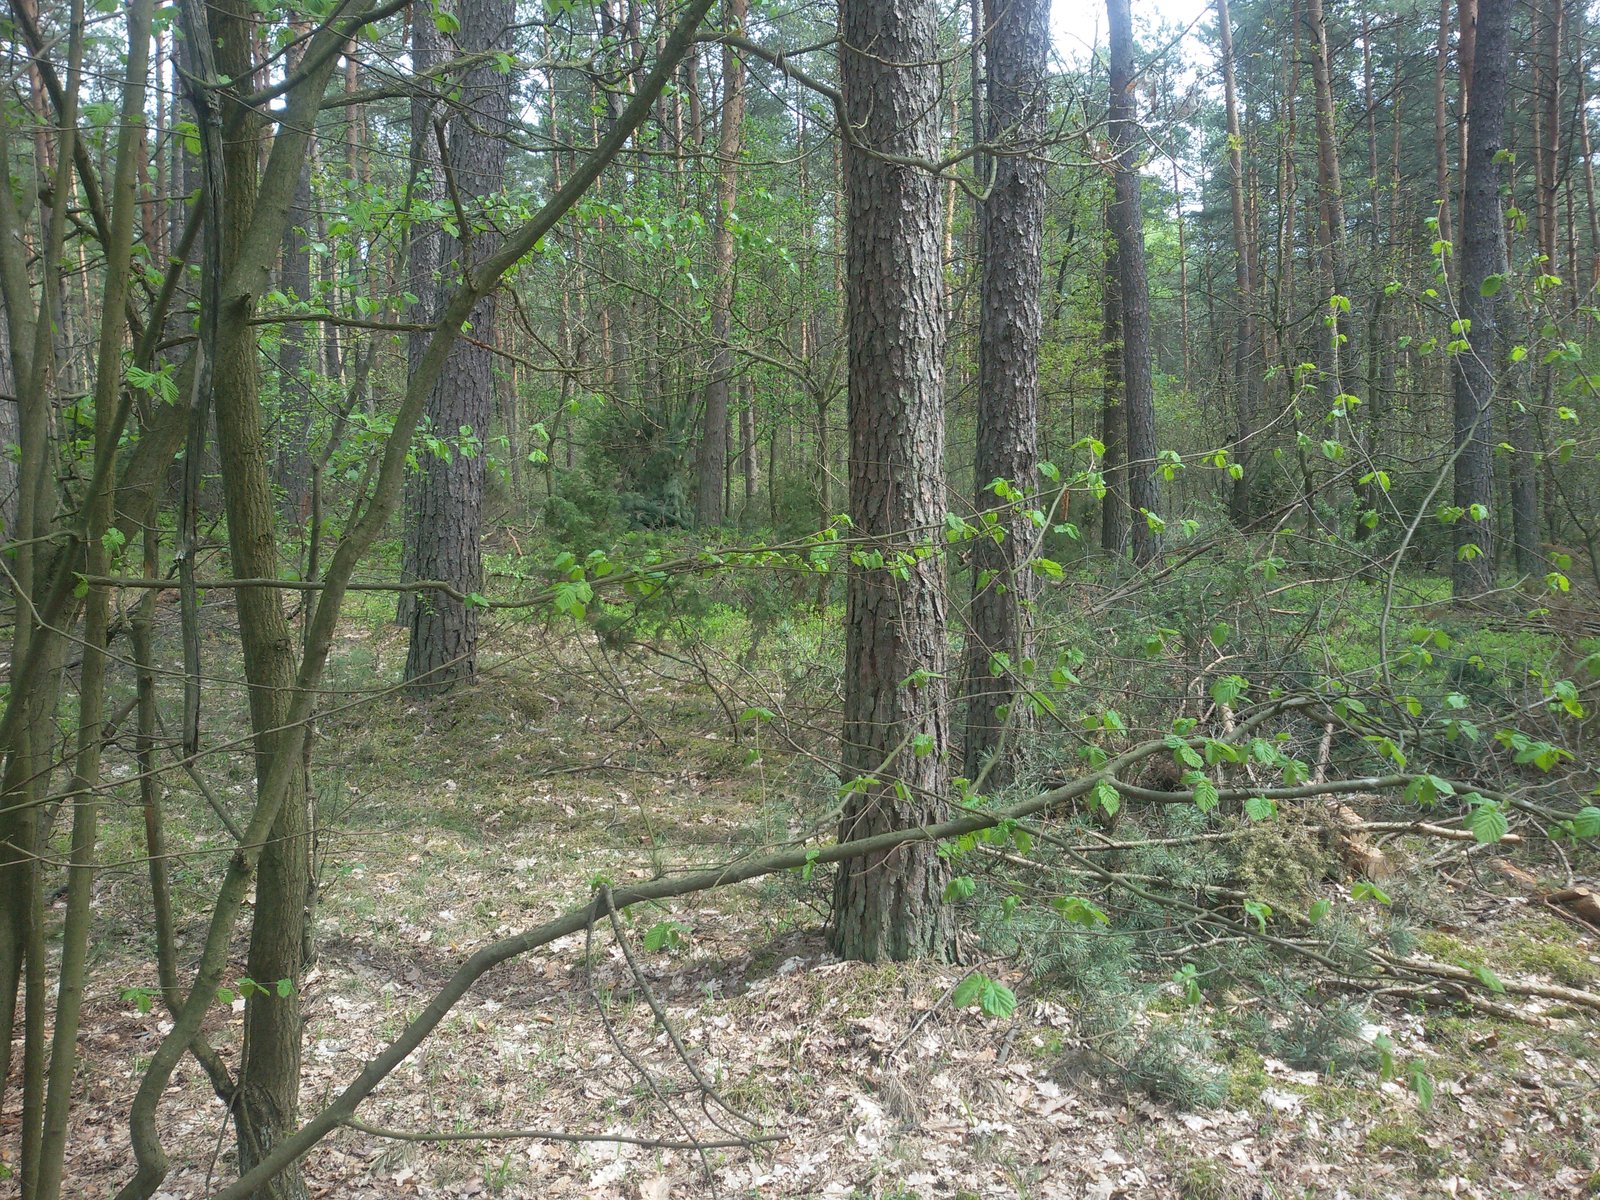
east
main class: Woodland
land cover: Pine dominated coniferous woodland
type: hemiboreal forest and nemoral coniferous forest and mixed broadleaved-coniferous forest
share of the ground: > 75 %
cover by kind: coniferous forest trees 90 %, shrubs 5 %, herbaceous plants 5 %
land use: Forestry
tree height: > 5 m
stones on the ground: < 10 %
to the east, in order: Pine dominated coniferous woodland; Tracks; Pine dominated coniferous woodland
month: May
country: PL
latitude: 52.9442
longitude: 22.0381
